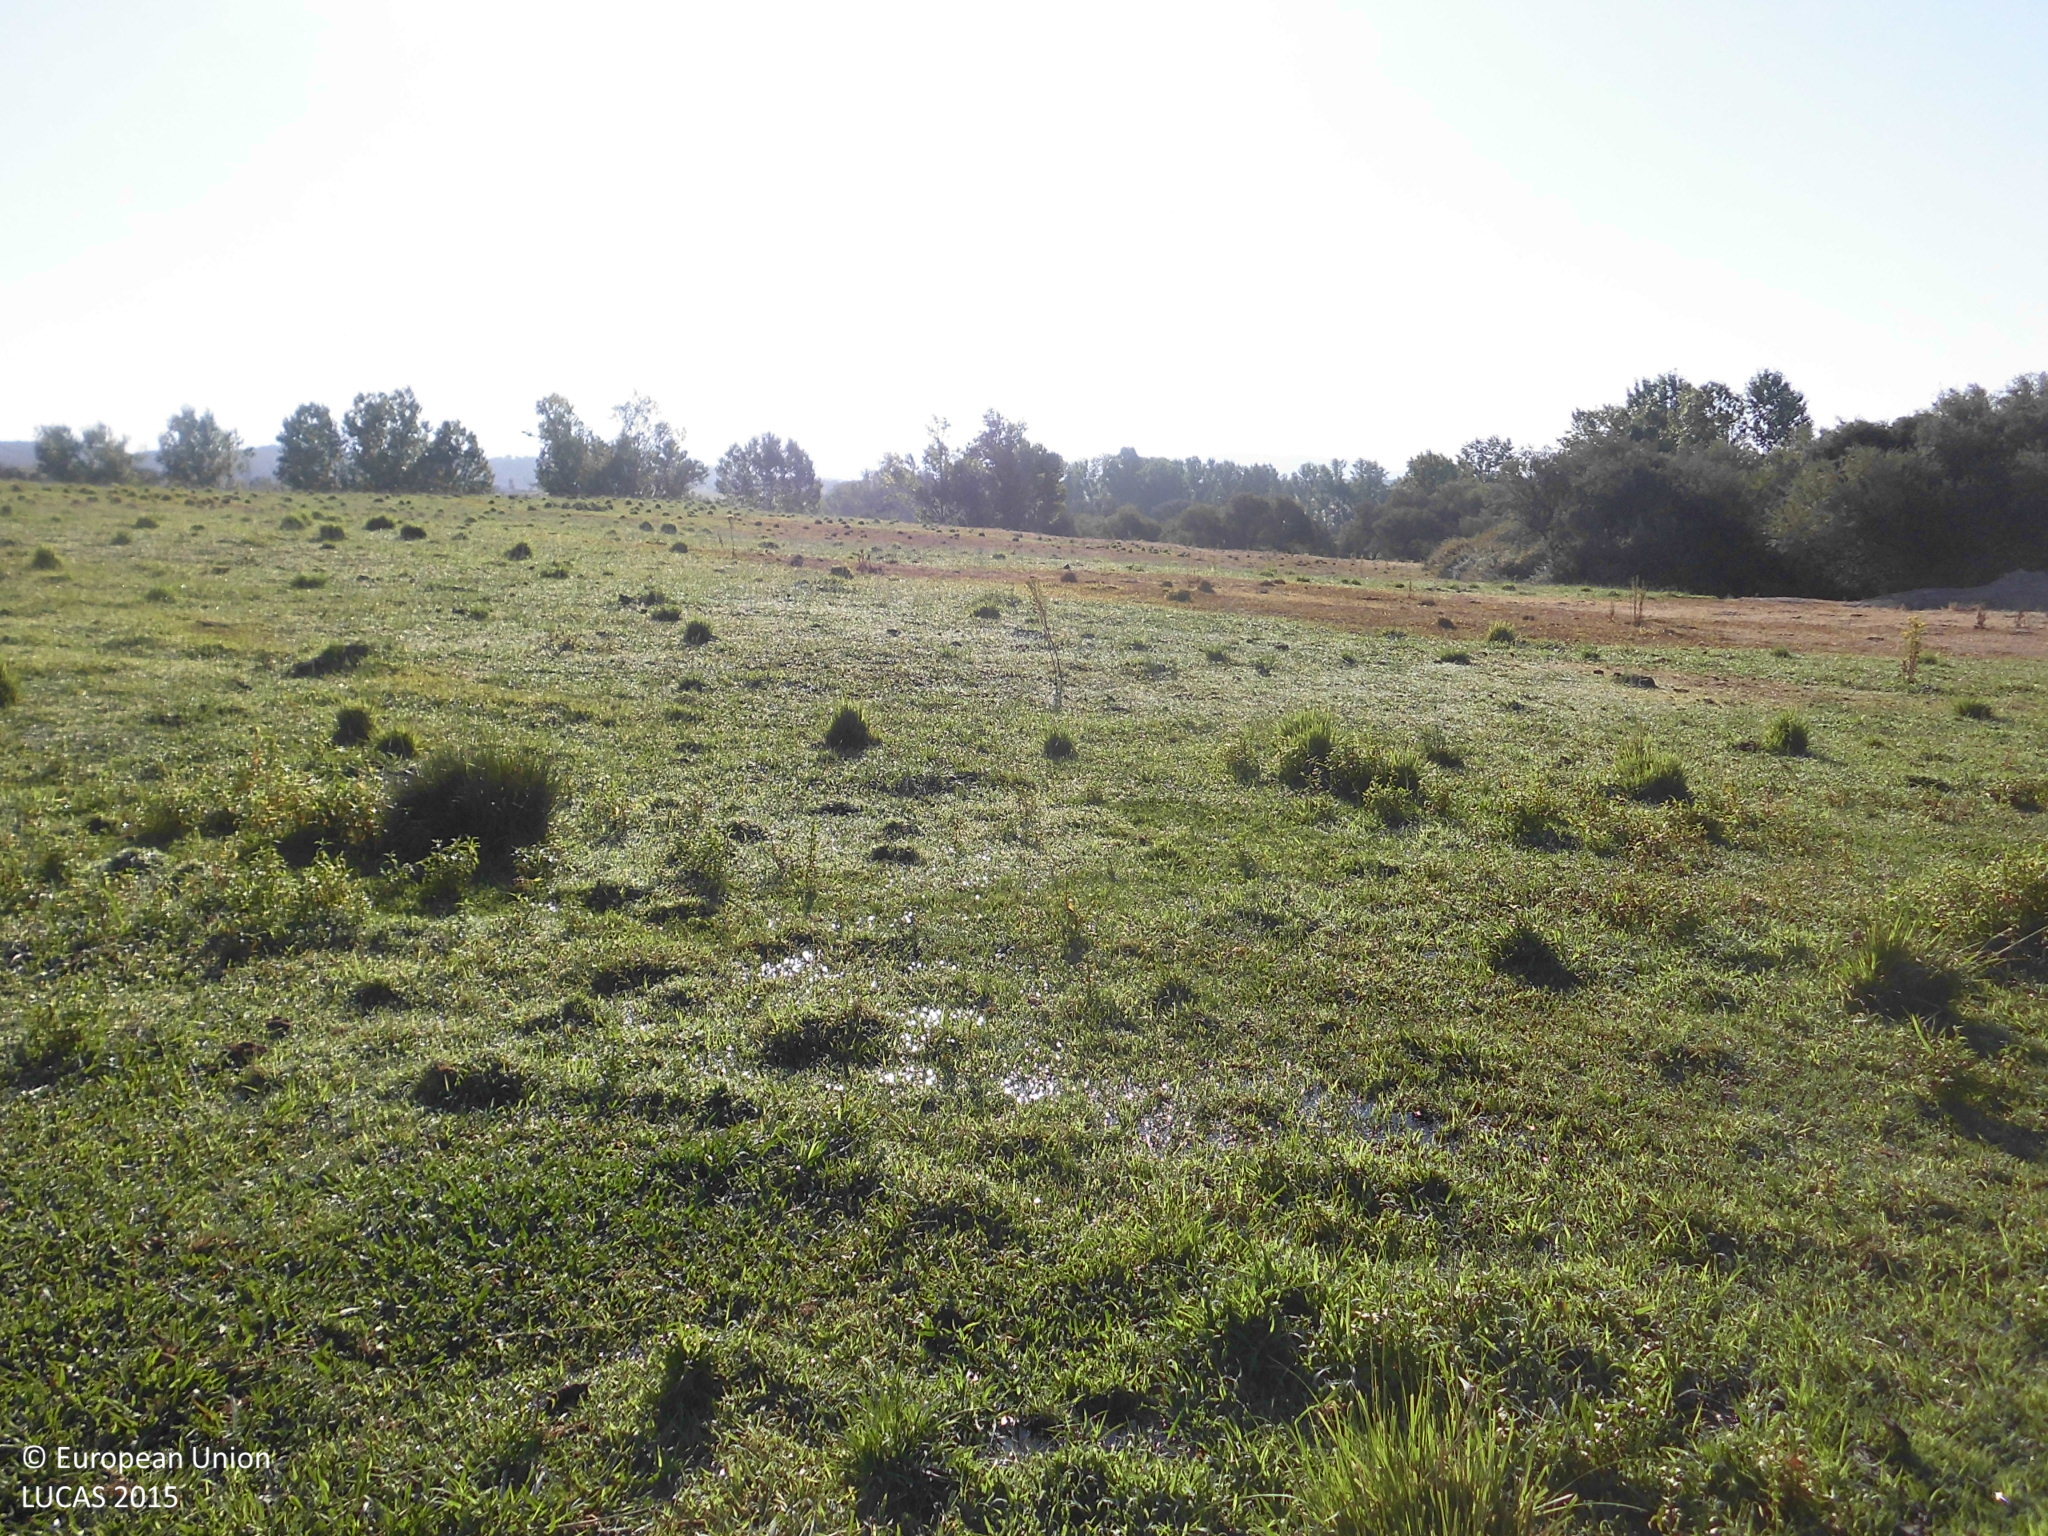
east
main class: Cropland
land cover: Temporary grasslands
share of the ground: > 75 %
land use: Agriculture (excluding fallow land and kitchen gardens)
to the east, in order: Temporary grasslands; Groves; Rivers and streams; Temporary grasslands
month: July
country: ES
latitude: 40.0673
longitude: -6.2197
